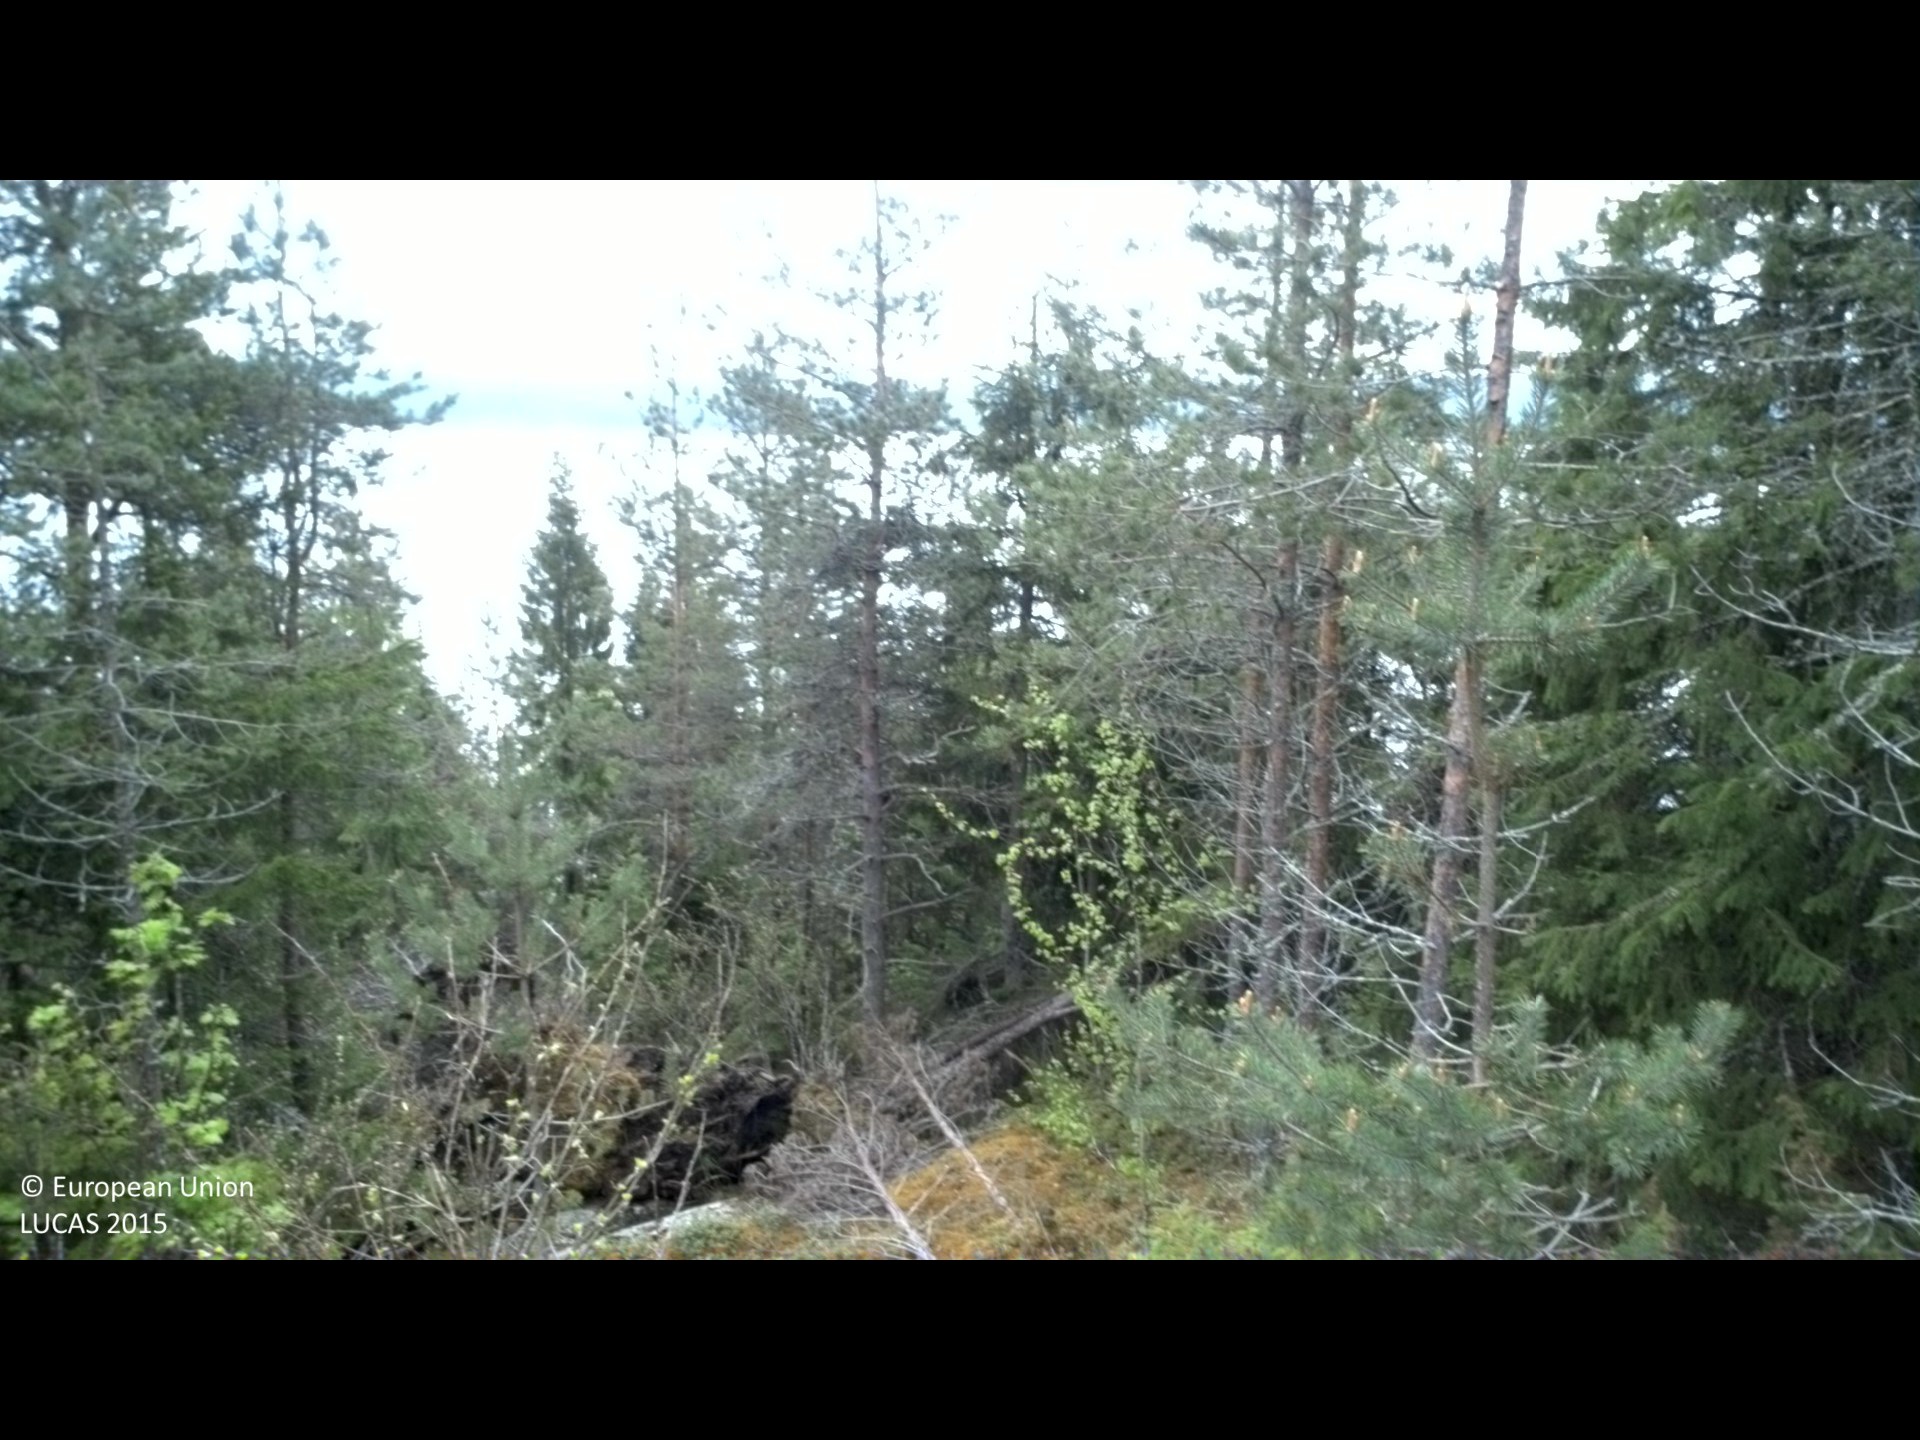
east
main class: Woodland
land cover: Pine dominated coniferous woodland
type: boreal forest
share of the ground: 50 - 75 %
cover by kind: coniferous forest trees 60 %, lichens and mosses 40 %
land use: Residential
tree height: > 5 m
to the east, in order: Pine dominated coniferous woodland; Pine dominated mixed woodland; Tracks; Other mixed woodland; Tracks; Other mixed woodland; Inland fresh water bodies
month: May
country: SE
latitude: 62.9559
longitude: 17.7649
